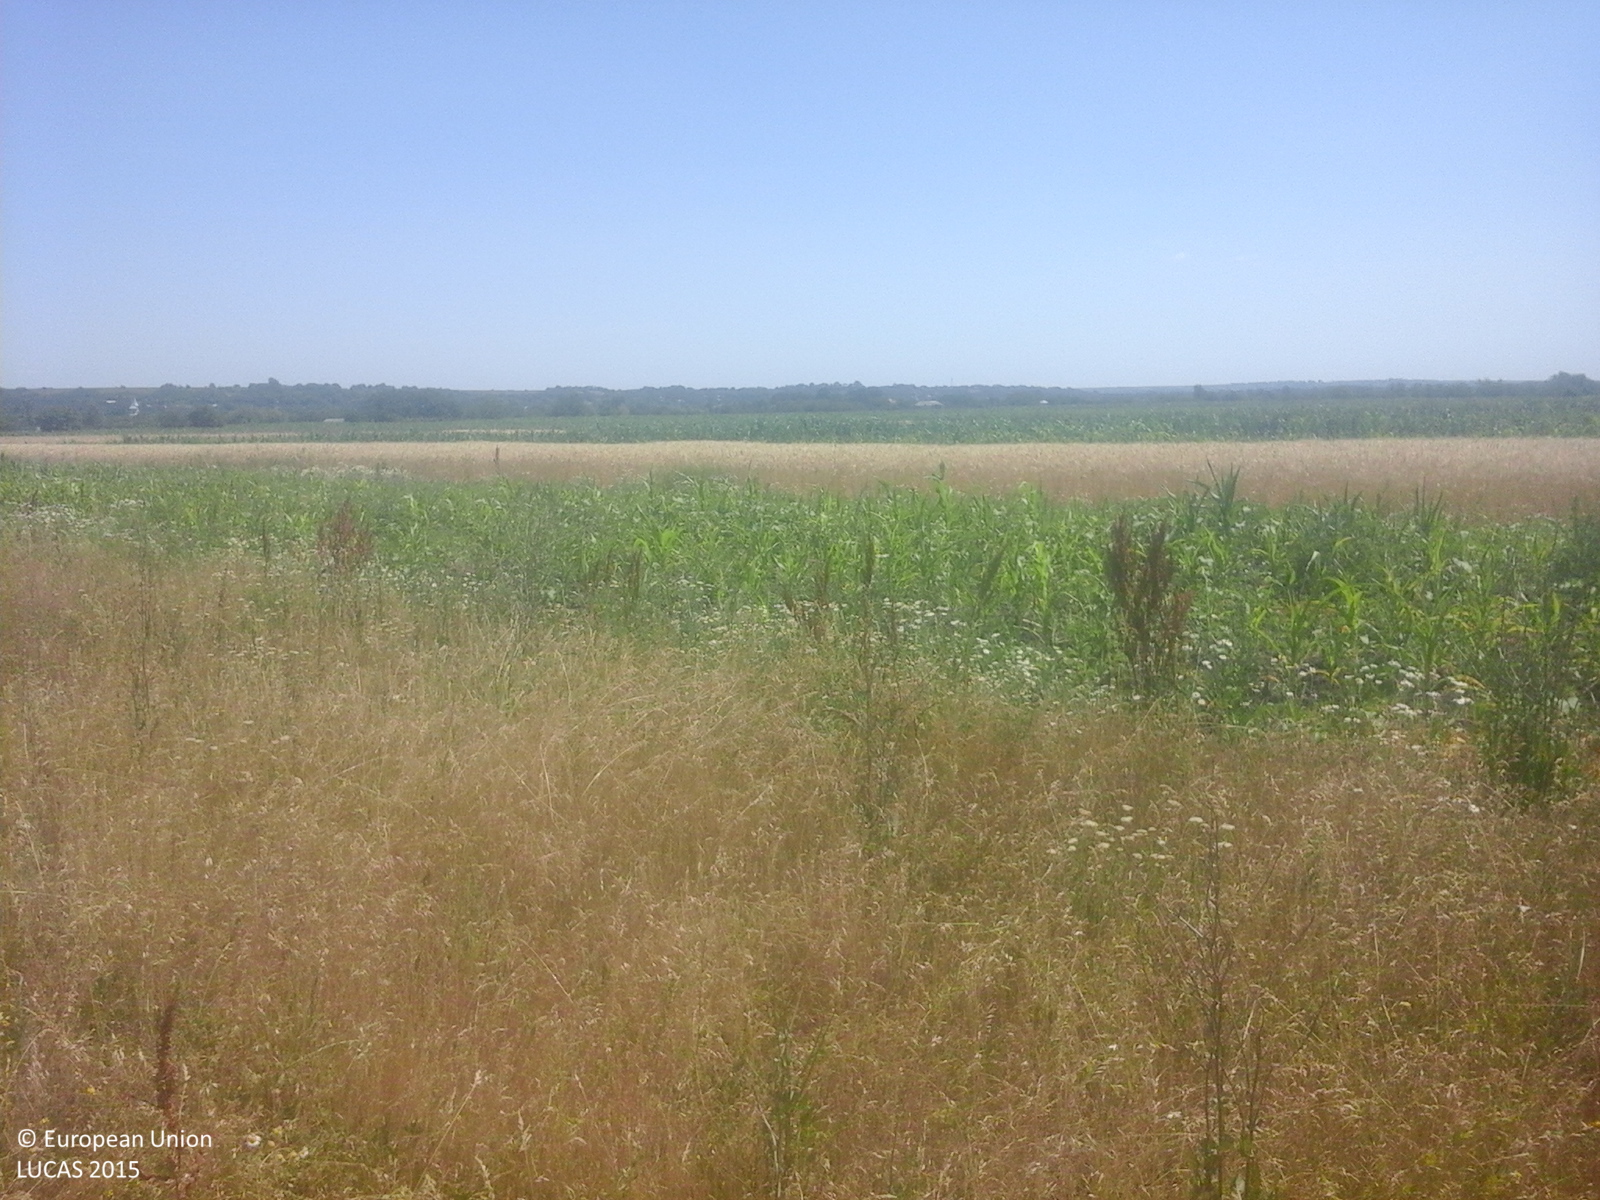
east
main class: Grassland
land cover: Grassland without tree/shrub cover
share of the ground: > 75 %
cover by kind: herbaceous plants 100 %
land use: Agriculture (excluding fallow land and kitchen gardens)
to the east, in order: Grassland without tree/shrub cover; Maize; Common wheat; Grass margins; Maize; Grassland without tree/shrub cover; Maize; Common wheat; Vineyards; Maize; Tracks; Maize; Lucerne; Maize
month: June
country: RO
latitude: 47.0793
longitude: 27.8676
